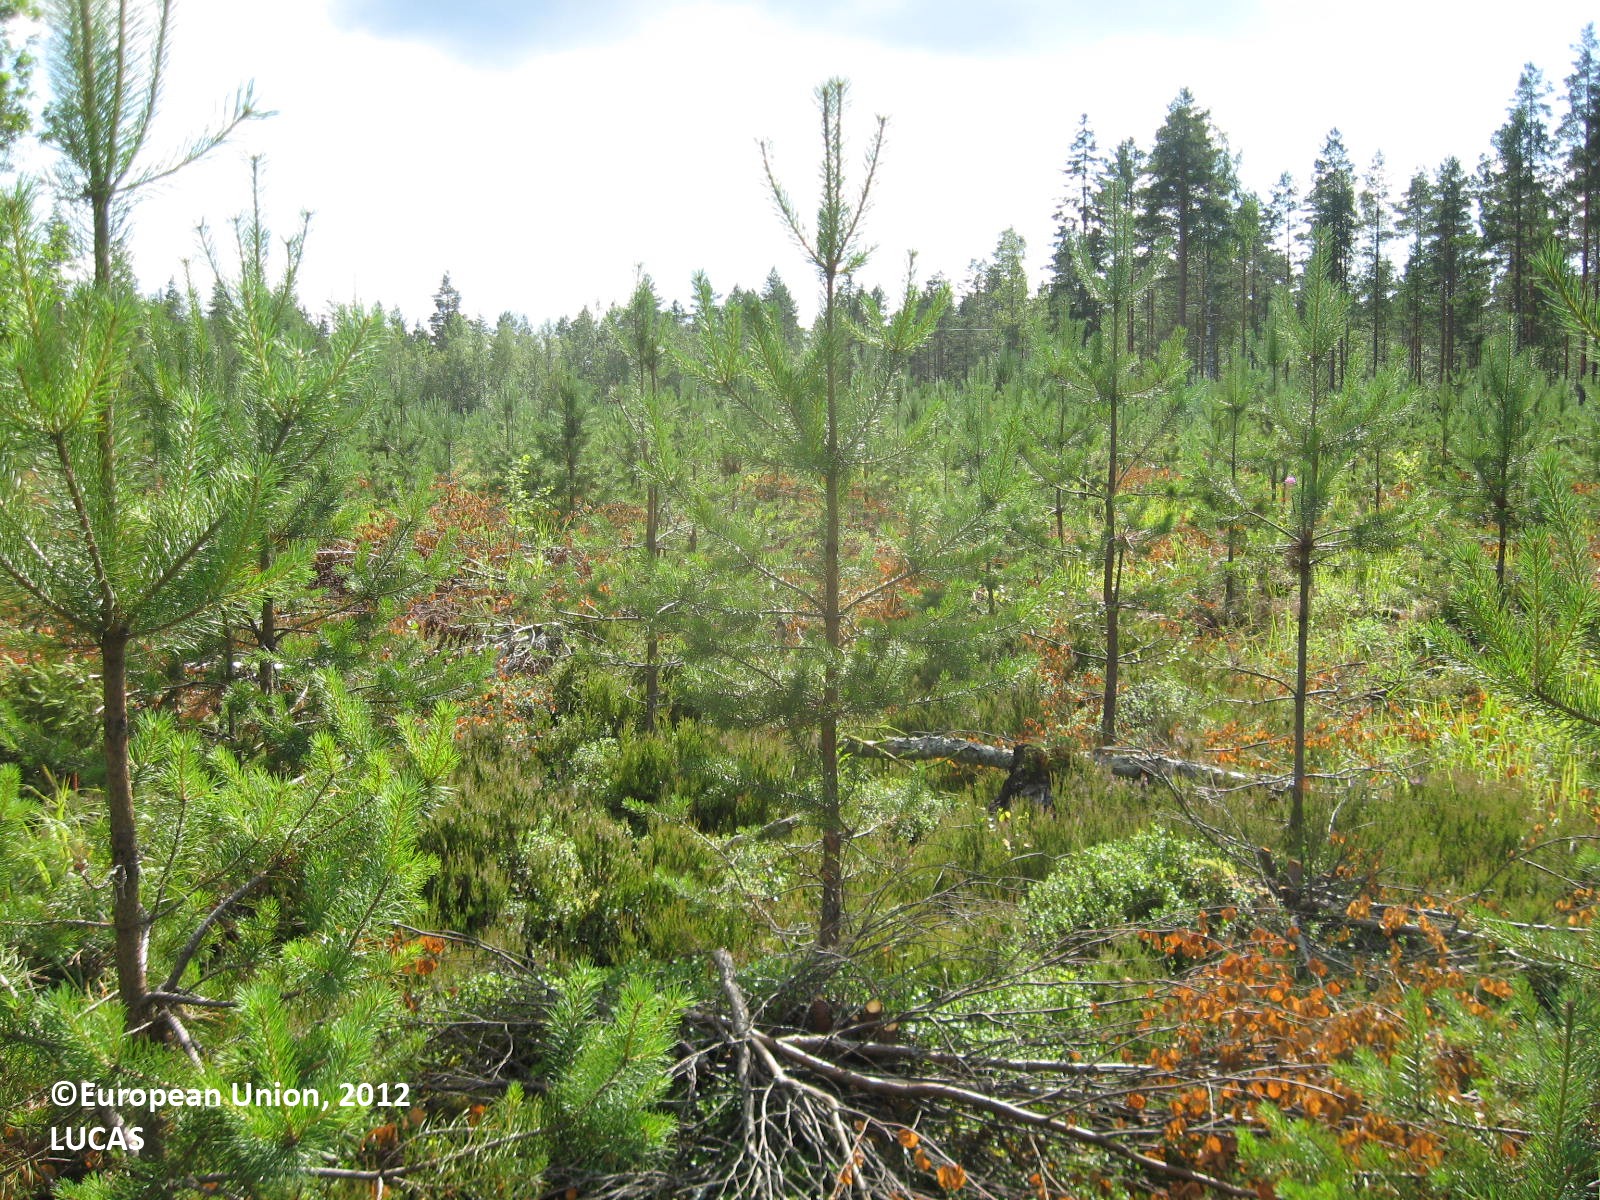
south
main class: Woodland
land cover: Pine dominated coniferous woodland
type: boreal forest
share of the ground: 25 - 50 %
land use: Forestry
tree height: < 5 m
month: July
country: FI
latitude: 62.0002
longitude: 22.6834
